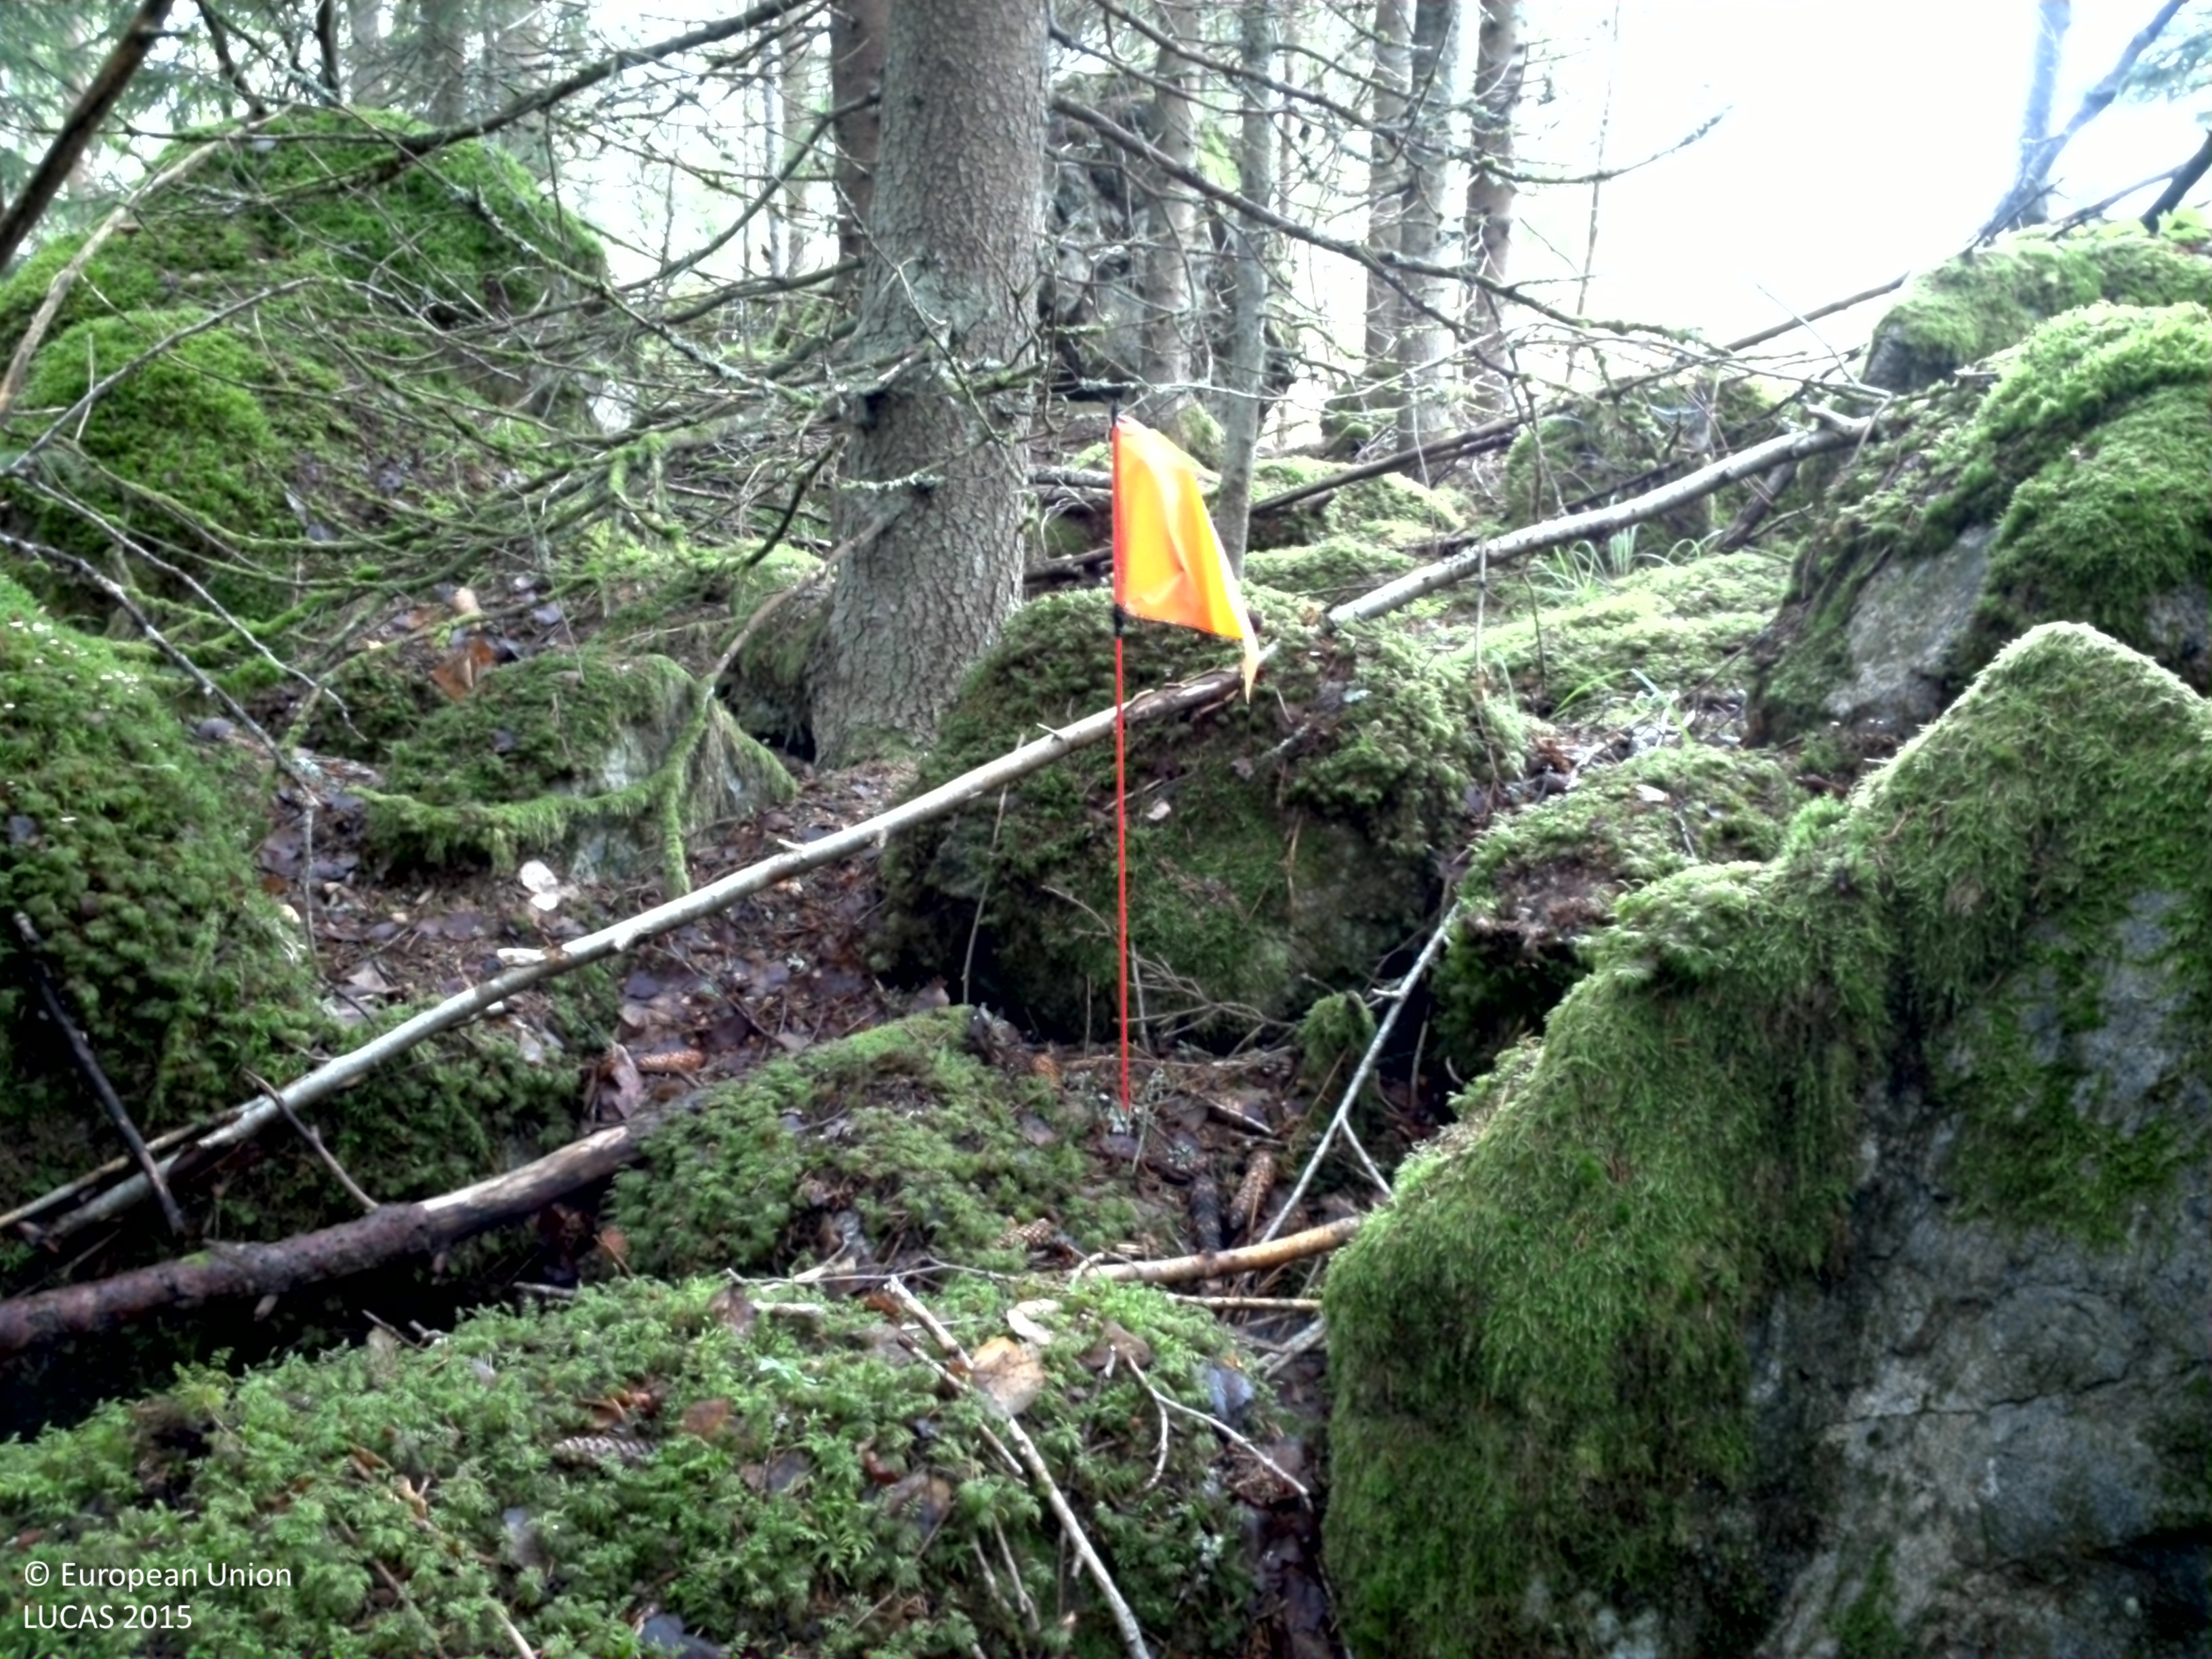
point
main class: Woodland
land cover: Spruce dominated coniferous woodland
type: boreal forest
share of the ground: > 75 %
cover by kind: coniferous forest trees 80 %, broadleaved forest trees 10 %, lichens and mosses 10 %
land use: Forestry
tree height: > 5 m
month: August
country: SE
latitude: 59.9231
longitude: 16.4844
